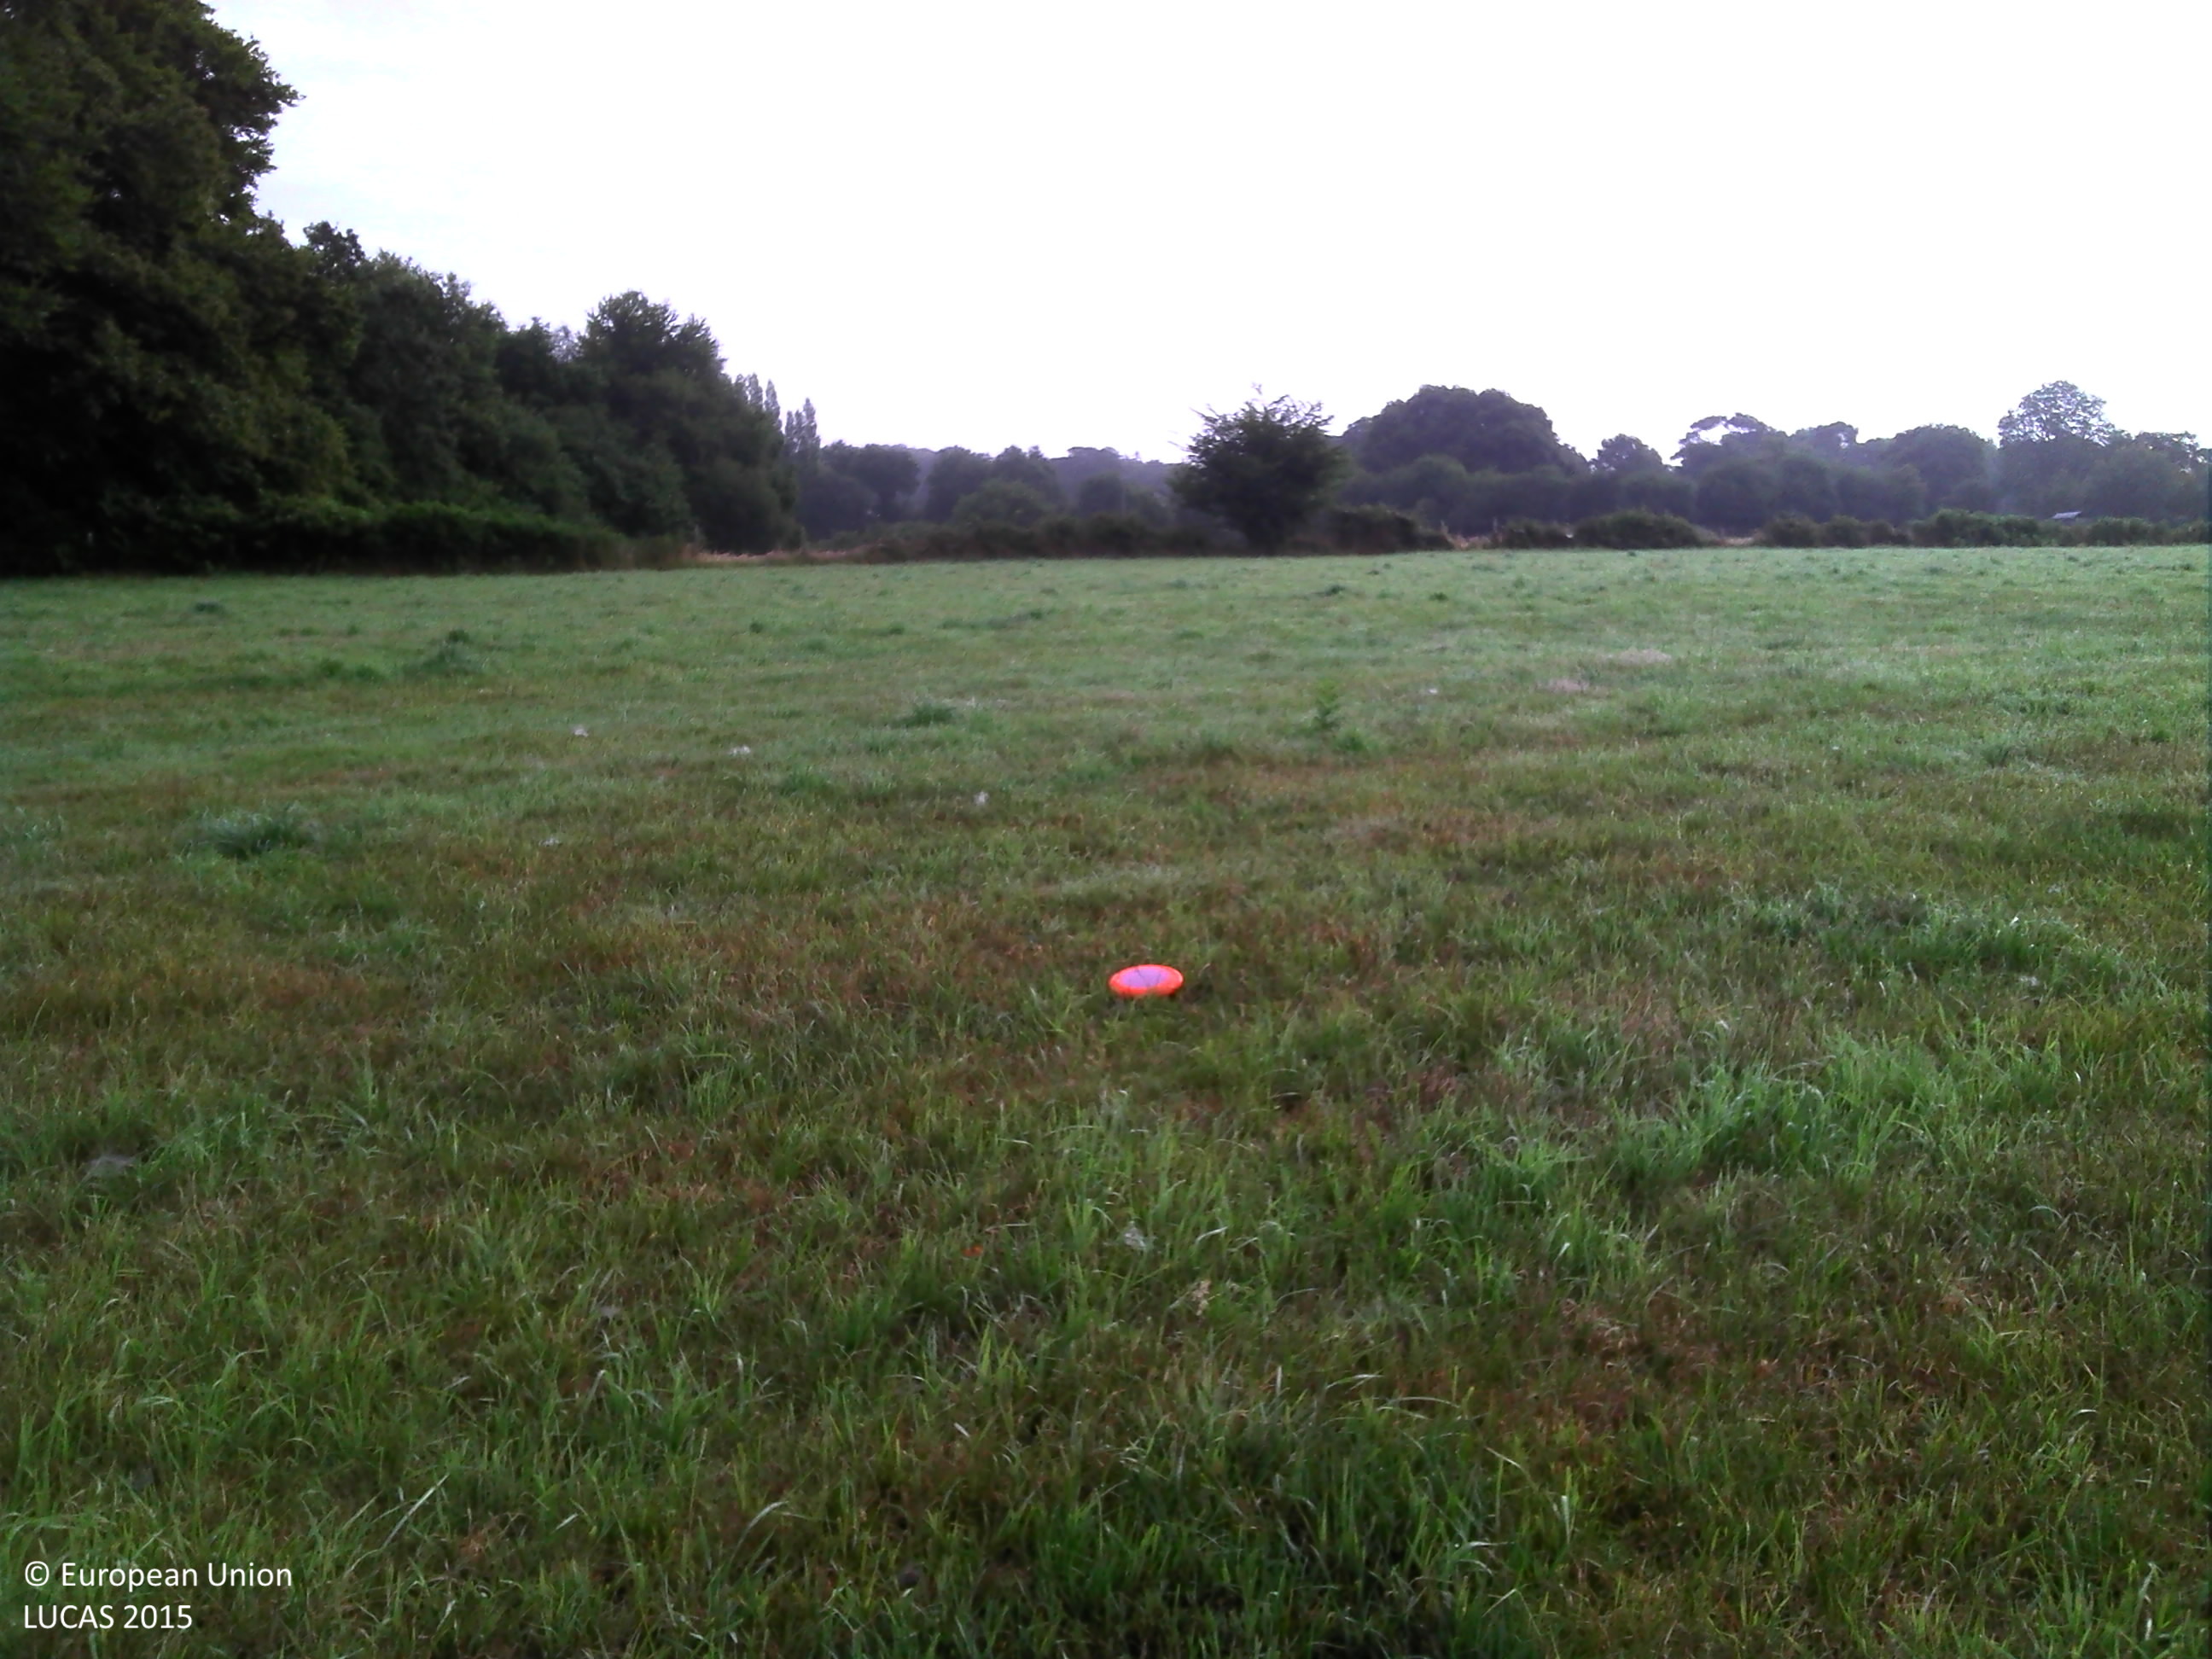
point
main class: Grassland
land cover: Grassland without tree/shrub cover
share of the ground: > 75 %
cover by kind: herbaceous plants 80 %, unconsolidated bare surface 20 %
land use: Agriculture (excluding fallow land and kitchen gardens)
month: July
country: FR
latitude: 47.7427
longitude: -2.9894
